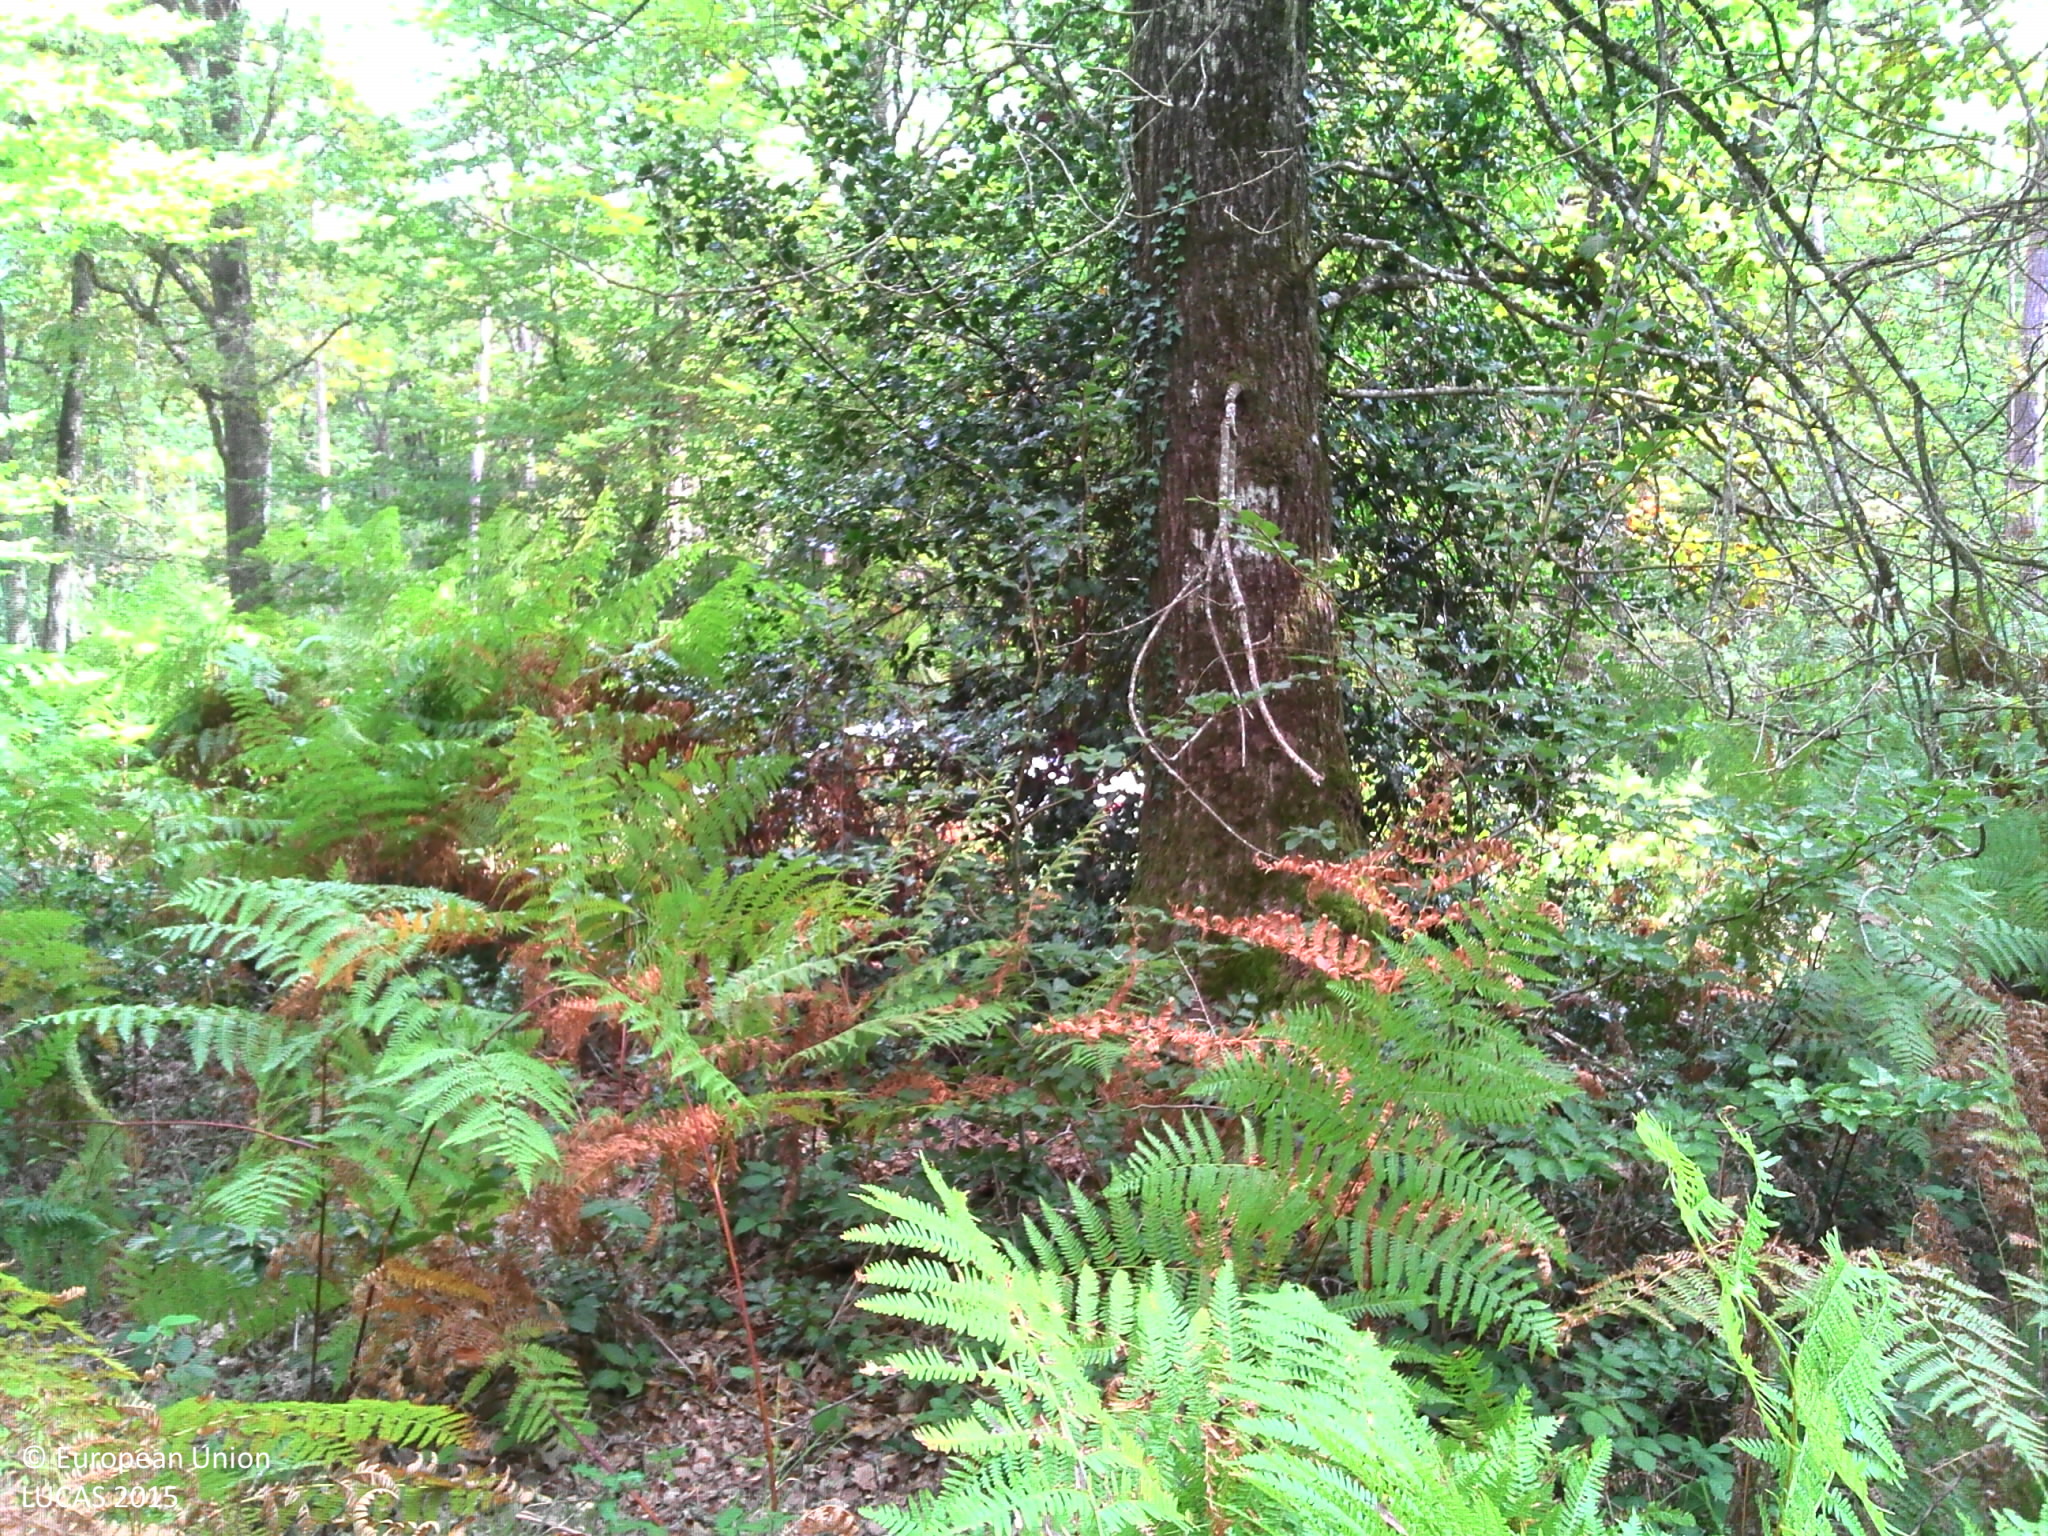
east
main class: Woodland
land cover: Pine dominated mixed woodland
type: mesophytic deciduous forest
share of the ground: > 75 %
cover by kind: broadleaved forest trees 50 %, coniferous forest trees 40 %, herbaceous plants 10 %
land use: Forestry
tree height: > 5 m
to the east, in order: Pine dominated mixed woodland; Ditches and canals; Grass margins; Tracks; Grass margins; Ditches and canals; Pine dominated mixed woodland; Broadleaved woodland
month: August
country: FR
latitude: 47.2688
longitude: 2.0732
